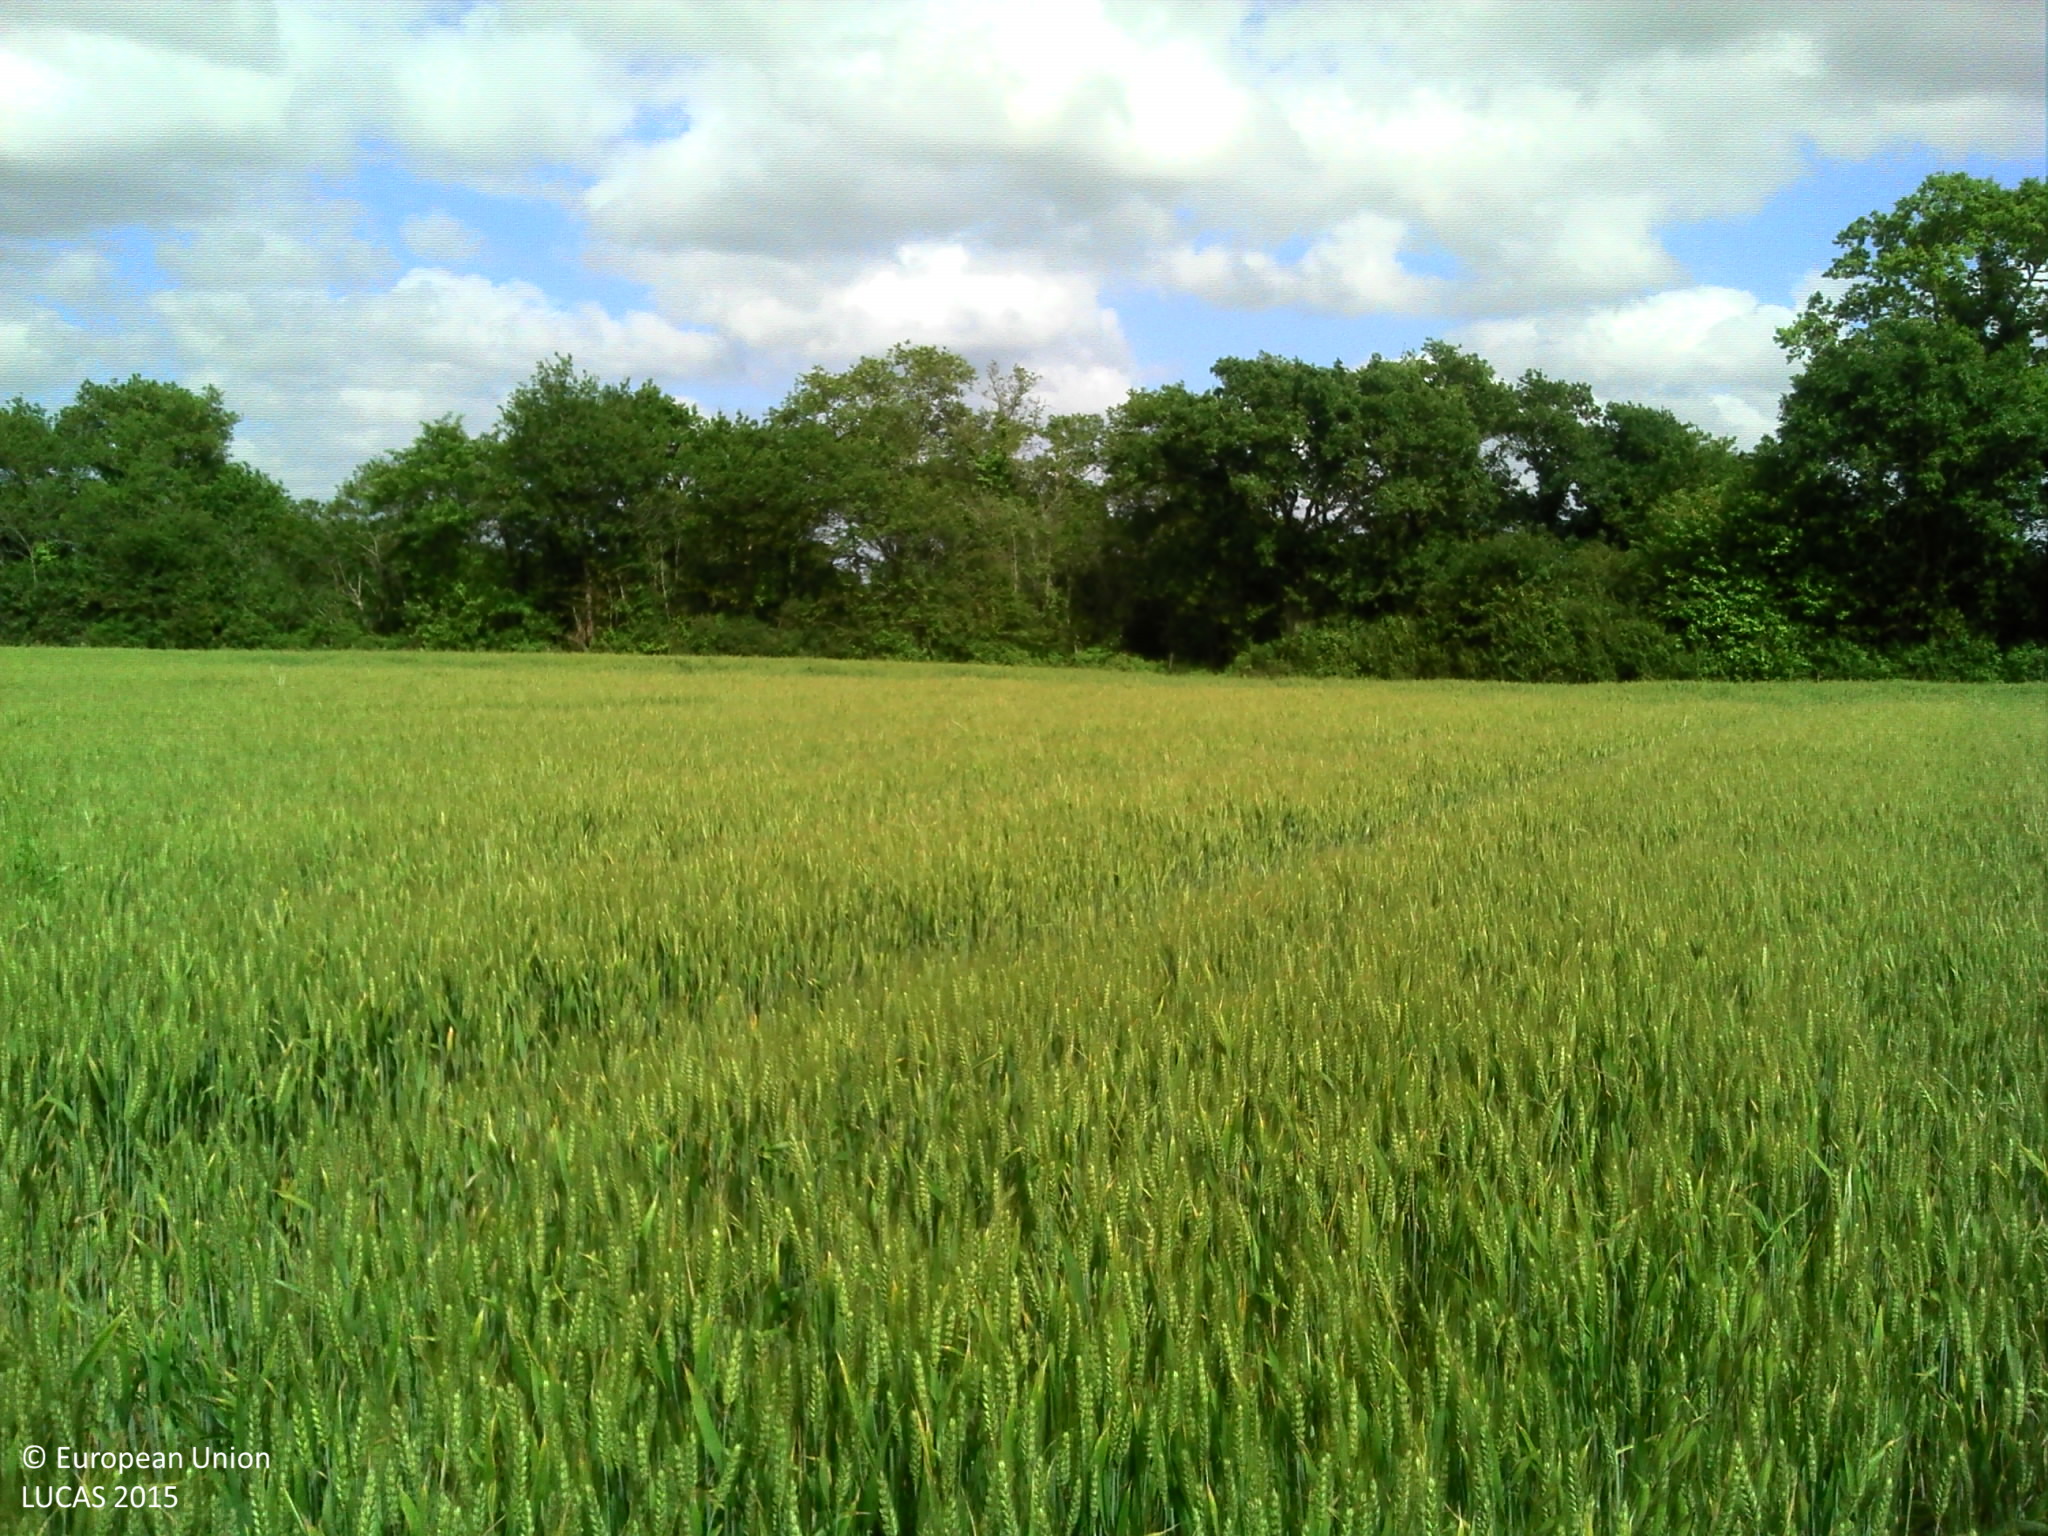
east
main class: Cropland
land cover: Common wheat
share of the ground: > 75 %
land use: Agriculture (excluding fallow land and kitchen gardens)
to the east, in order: Common wheat; Fences; Lines of trees; Tracks; Lines of trees; Fences; Ditches and canals; Grassland without tree/shrub cover; Ditches and canals; Lines of trees; Ditches and canals; Grass margins; Tracks; Grass margins; Ditches and canals; Abandoned hedges; Fences; Maize
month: June
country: FR
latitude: 46.8737
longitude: -1.8393
